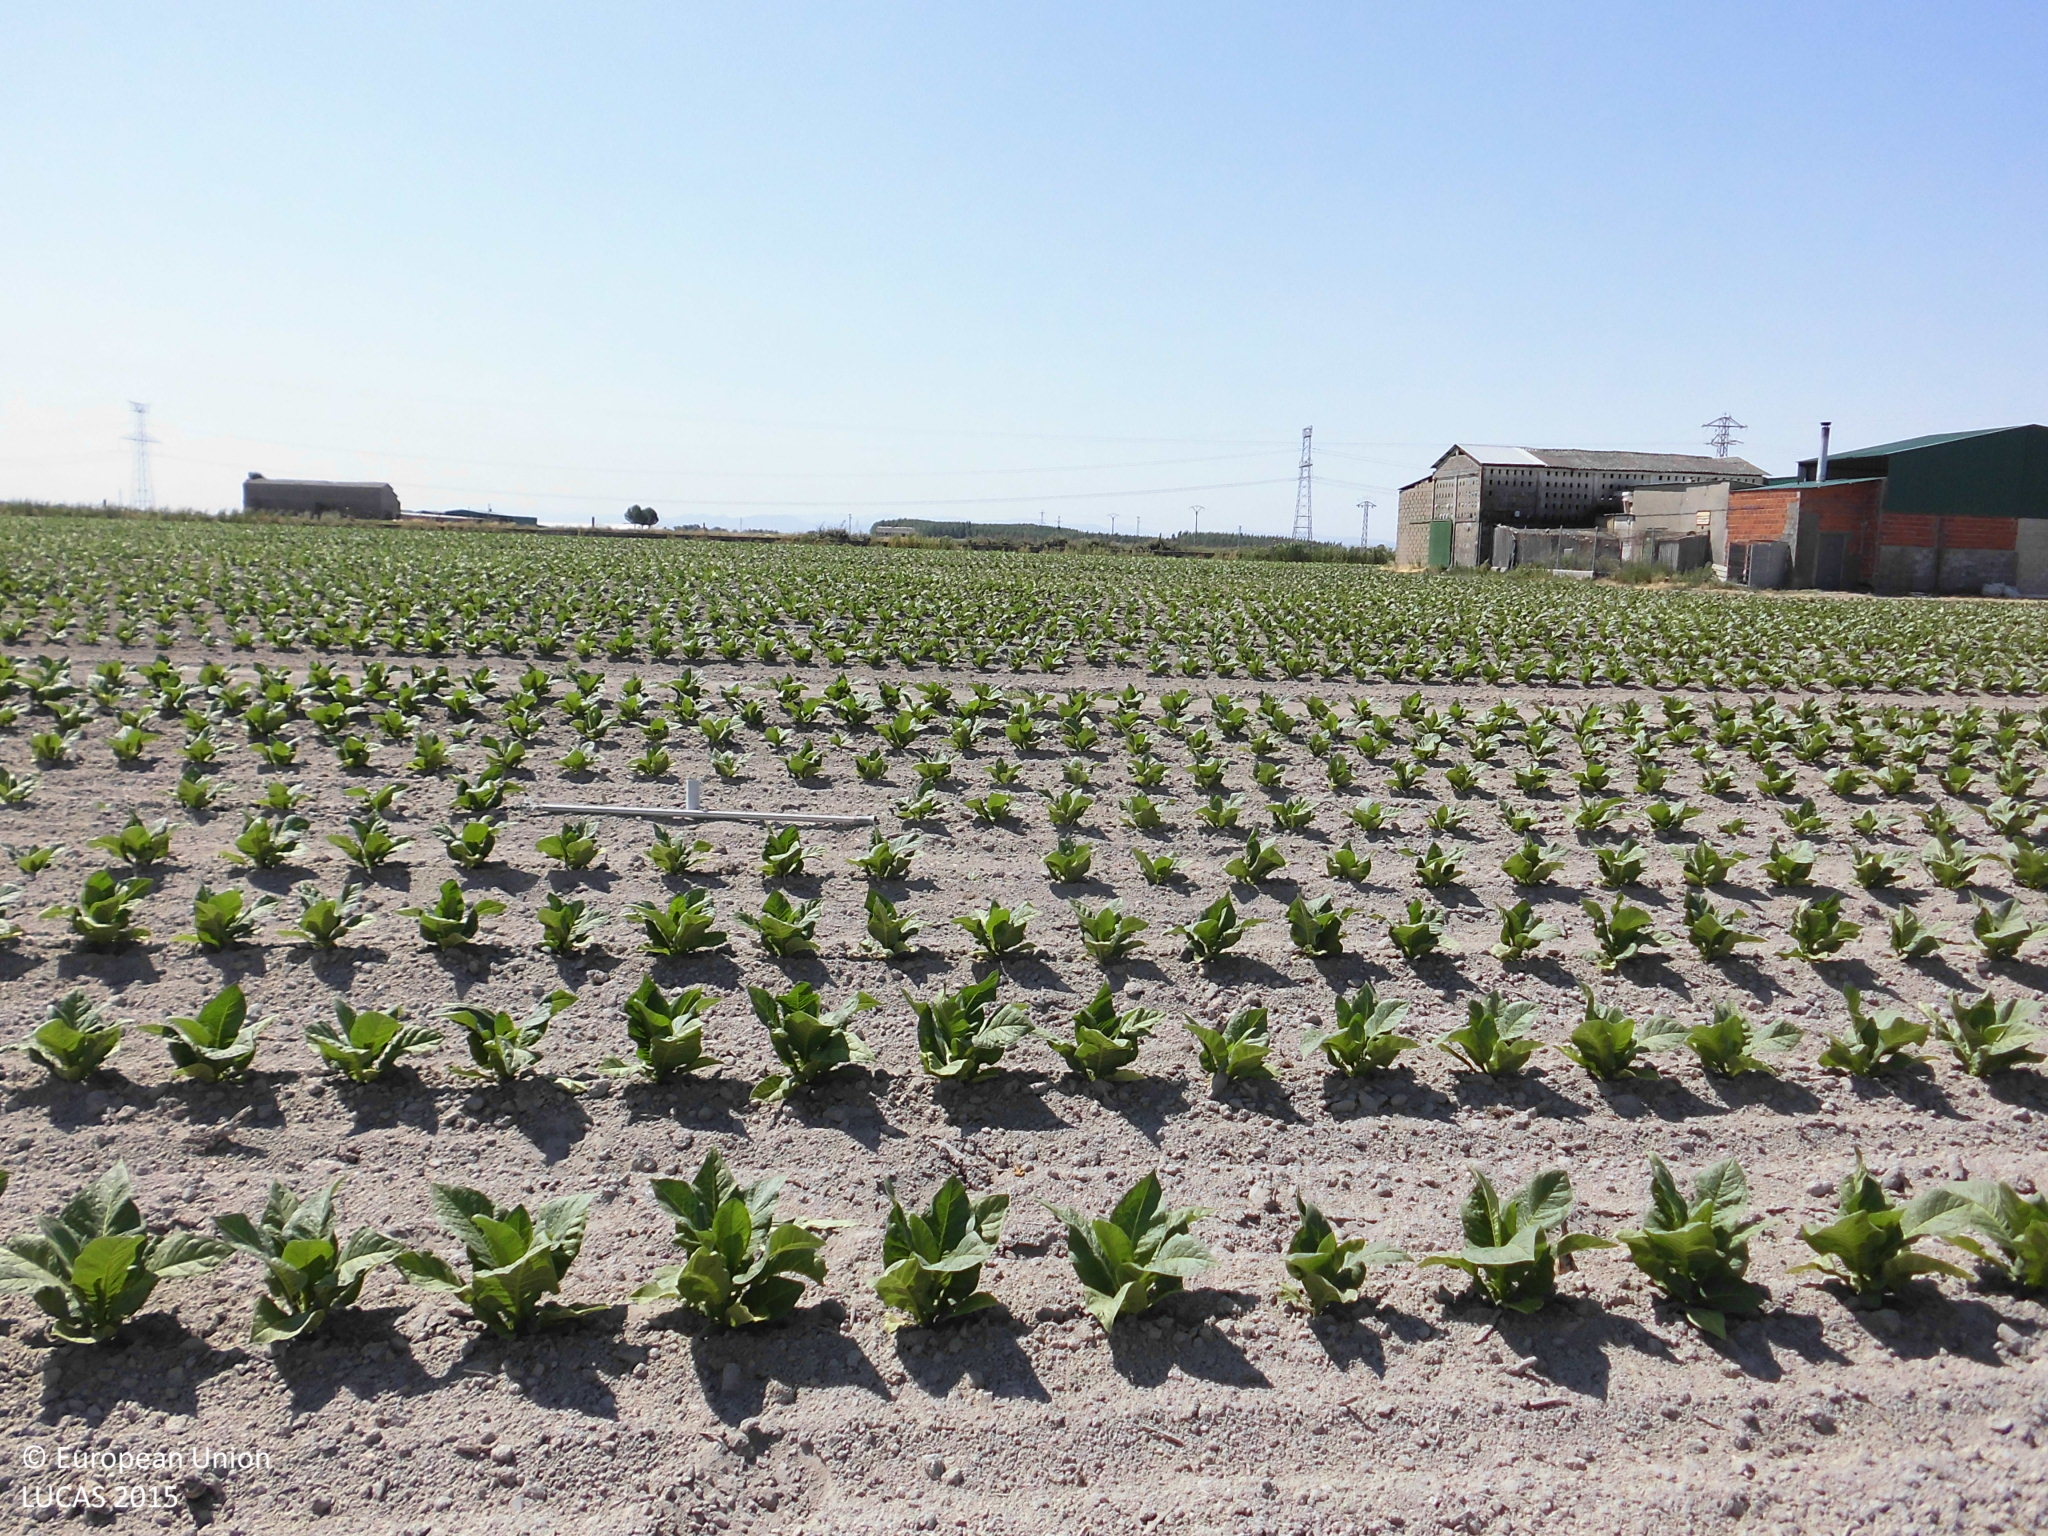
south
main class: Cropland
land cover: Tobacco
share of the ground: 10 - 25 %
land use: Agriculture (excluding fallow land and kitchen gardens)
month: June
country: ES
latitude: 39.9931
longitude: -5.4365
